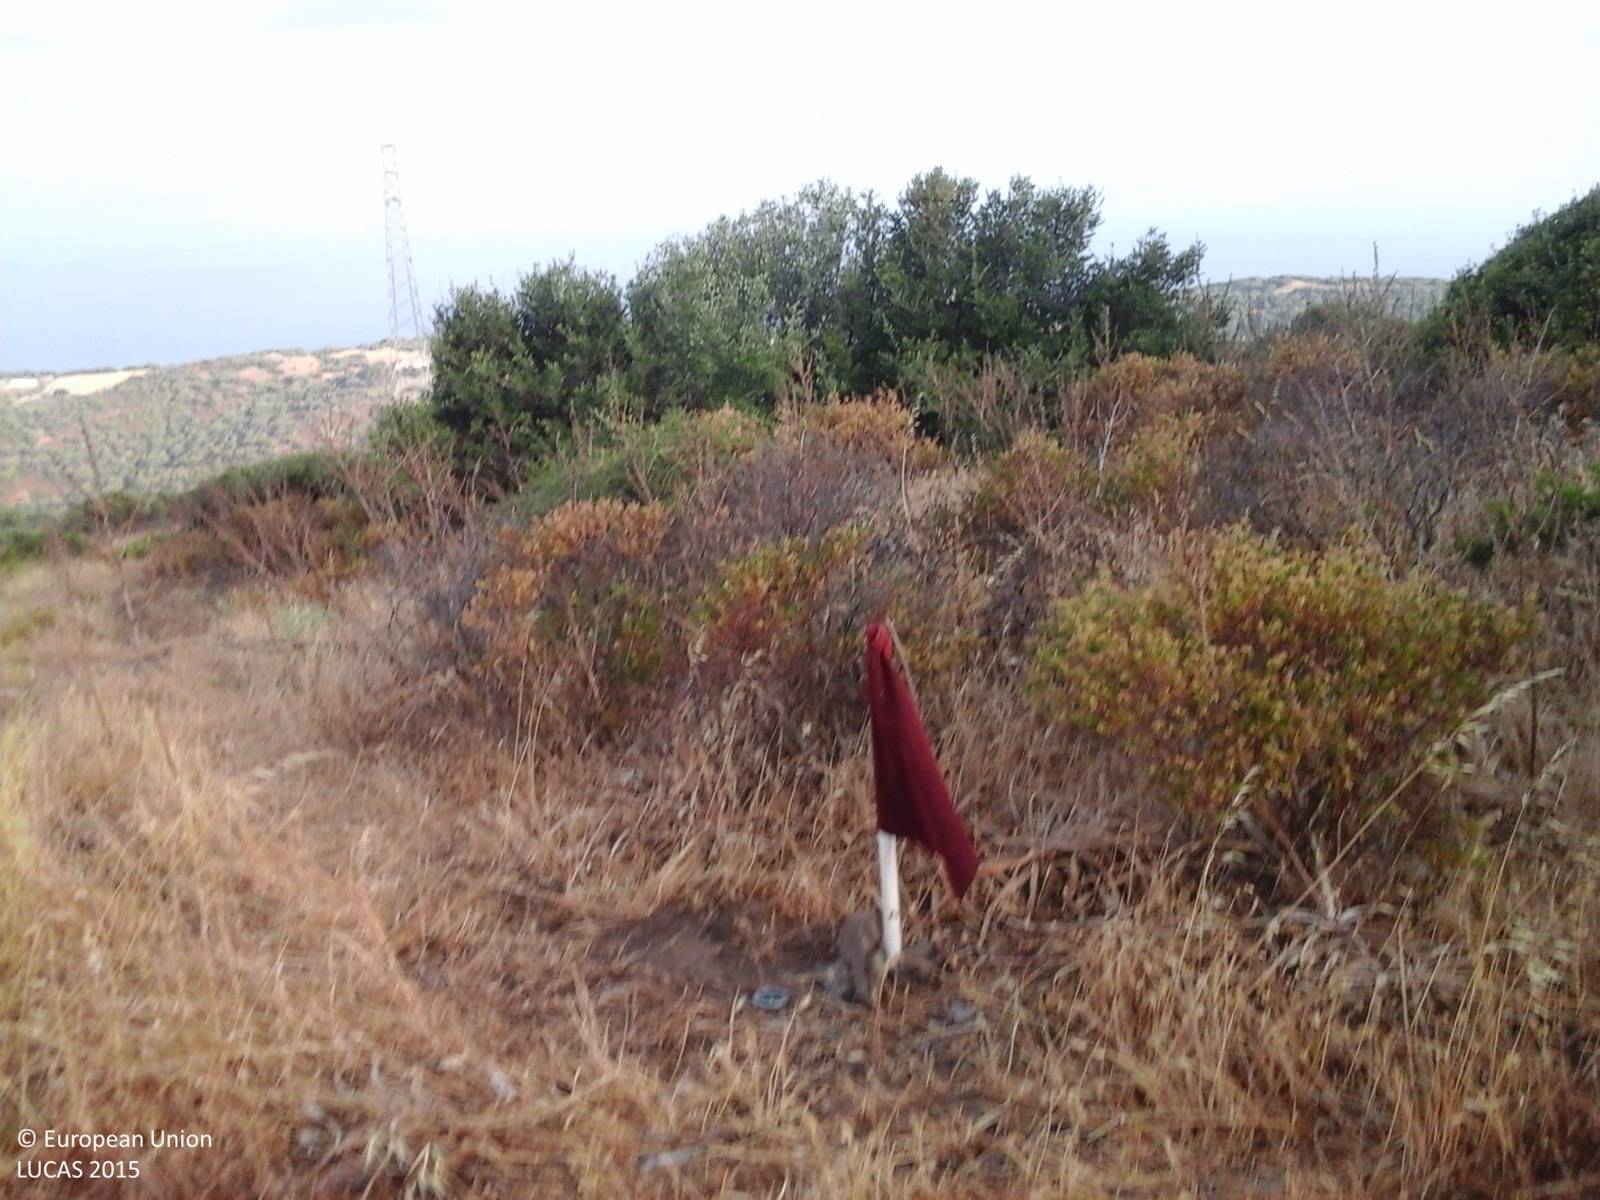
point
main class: Shrubland
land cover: Shrubland without tree cover
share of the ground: > 75 %
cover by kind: herbaceous plants 50 %, shrubs 40 %, consolidated bare surface 10 %
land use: Agriculture (excluding fallow land and kitchen gardens)
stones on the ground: < 10 %
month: June
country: IT
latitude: 40.9851
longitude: 8.8997
